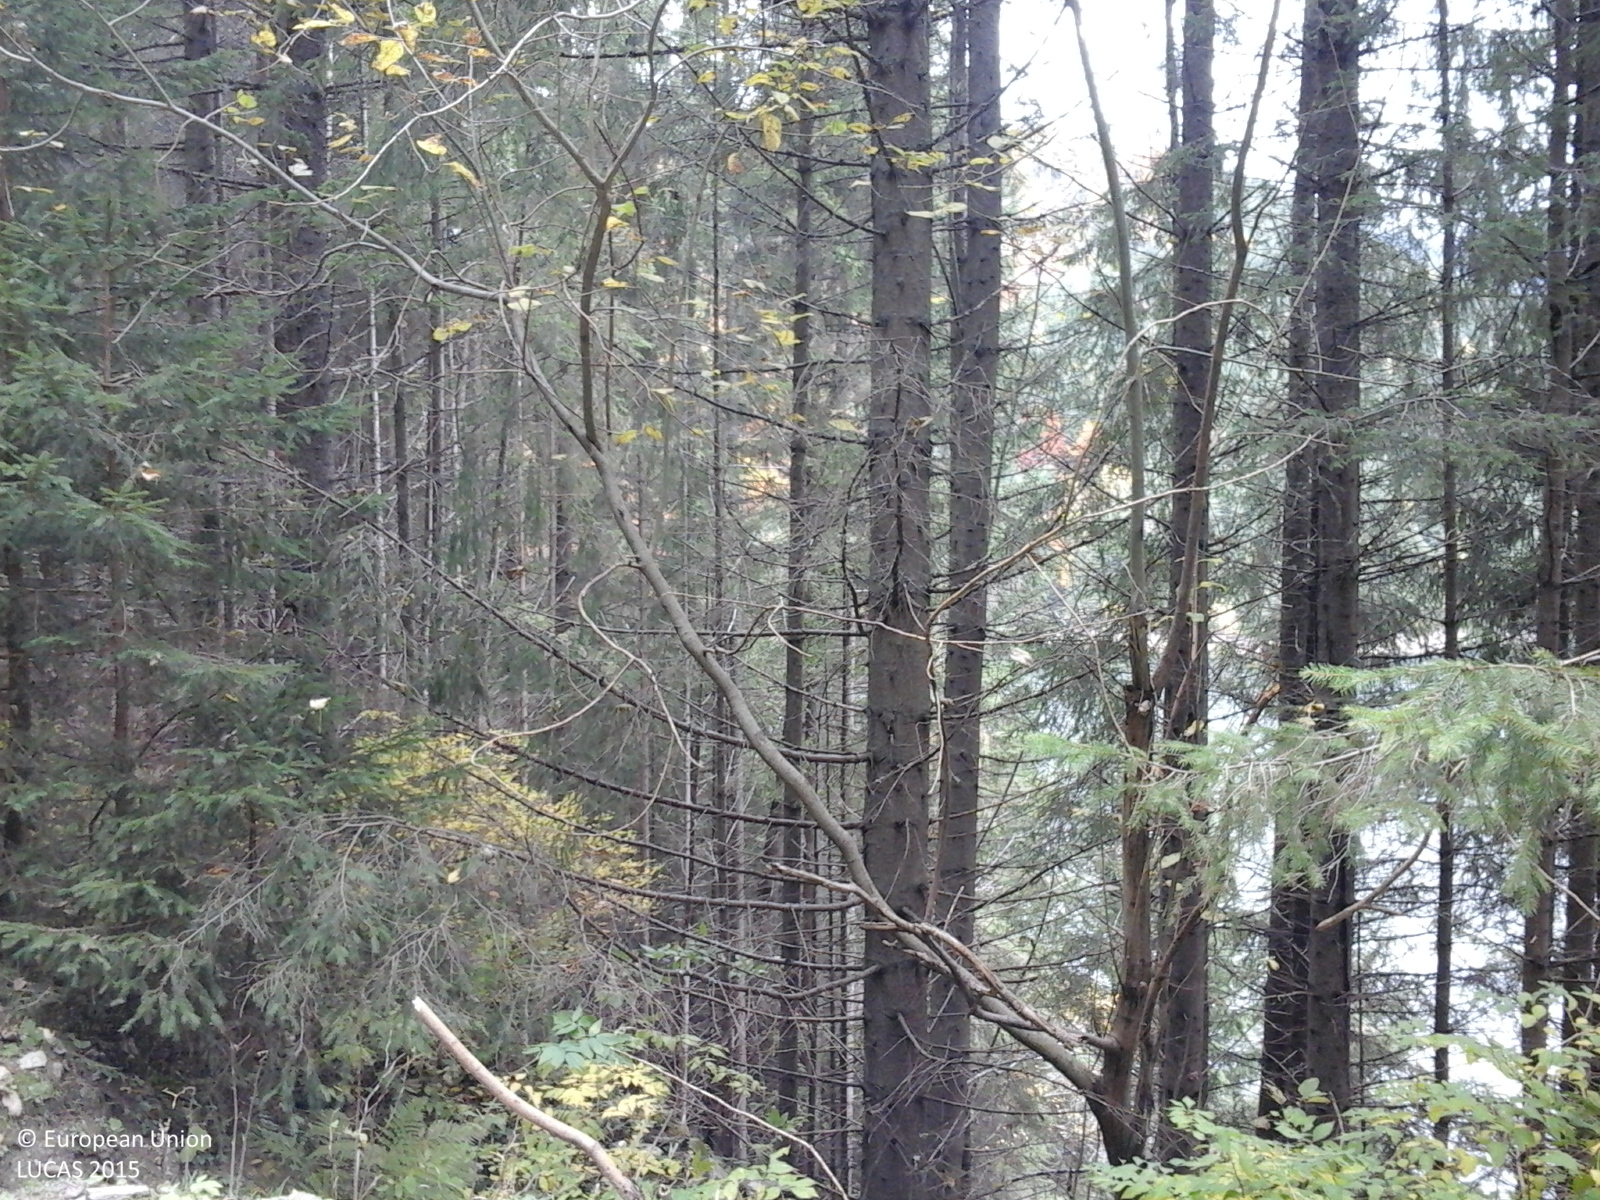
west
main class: Woodland
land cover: Spruce dominated mixed woodland
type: alpine coniferous forest
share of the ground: > 75 %
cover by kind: coniferous forest trees 75 %, broadleaved forest trees 25 %
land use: Forestry
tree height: > 5 m
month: October
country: RO
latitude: 45.5688
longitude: 25.0706
